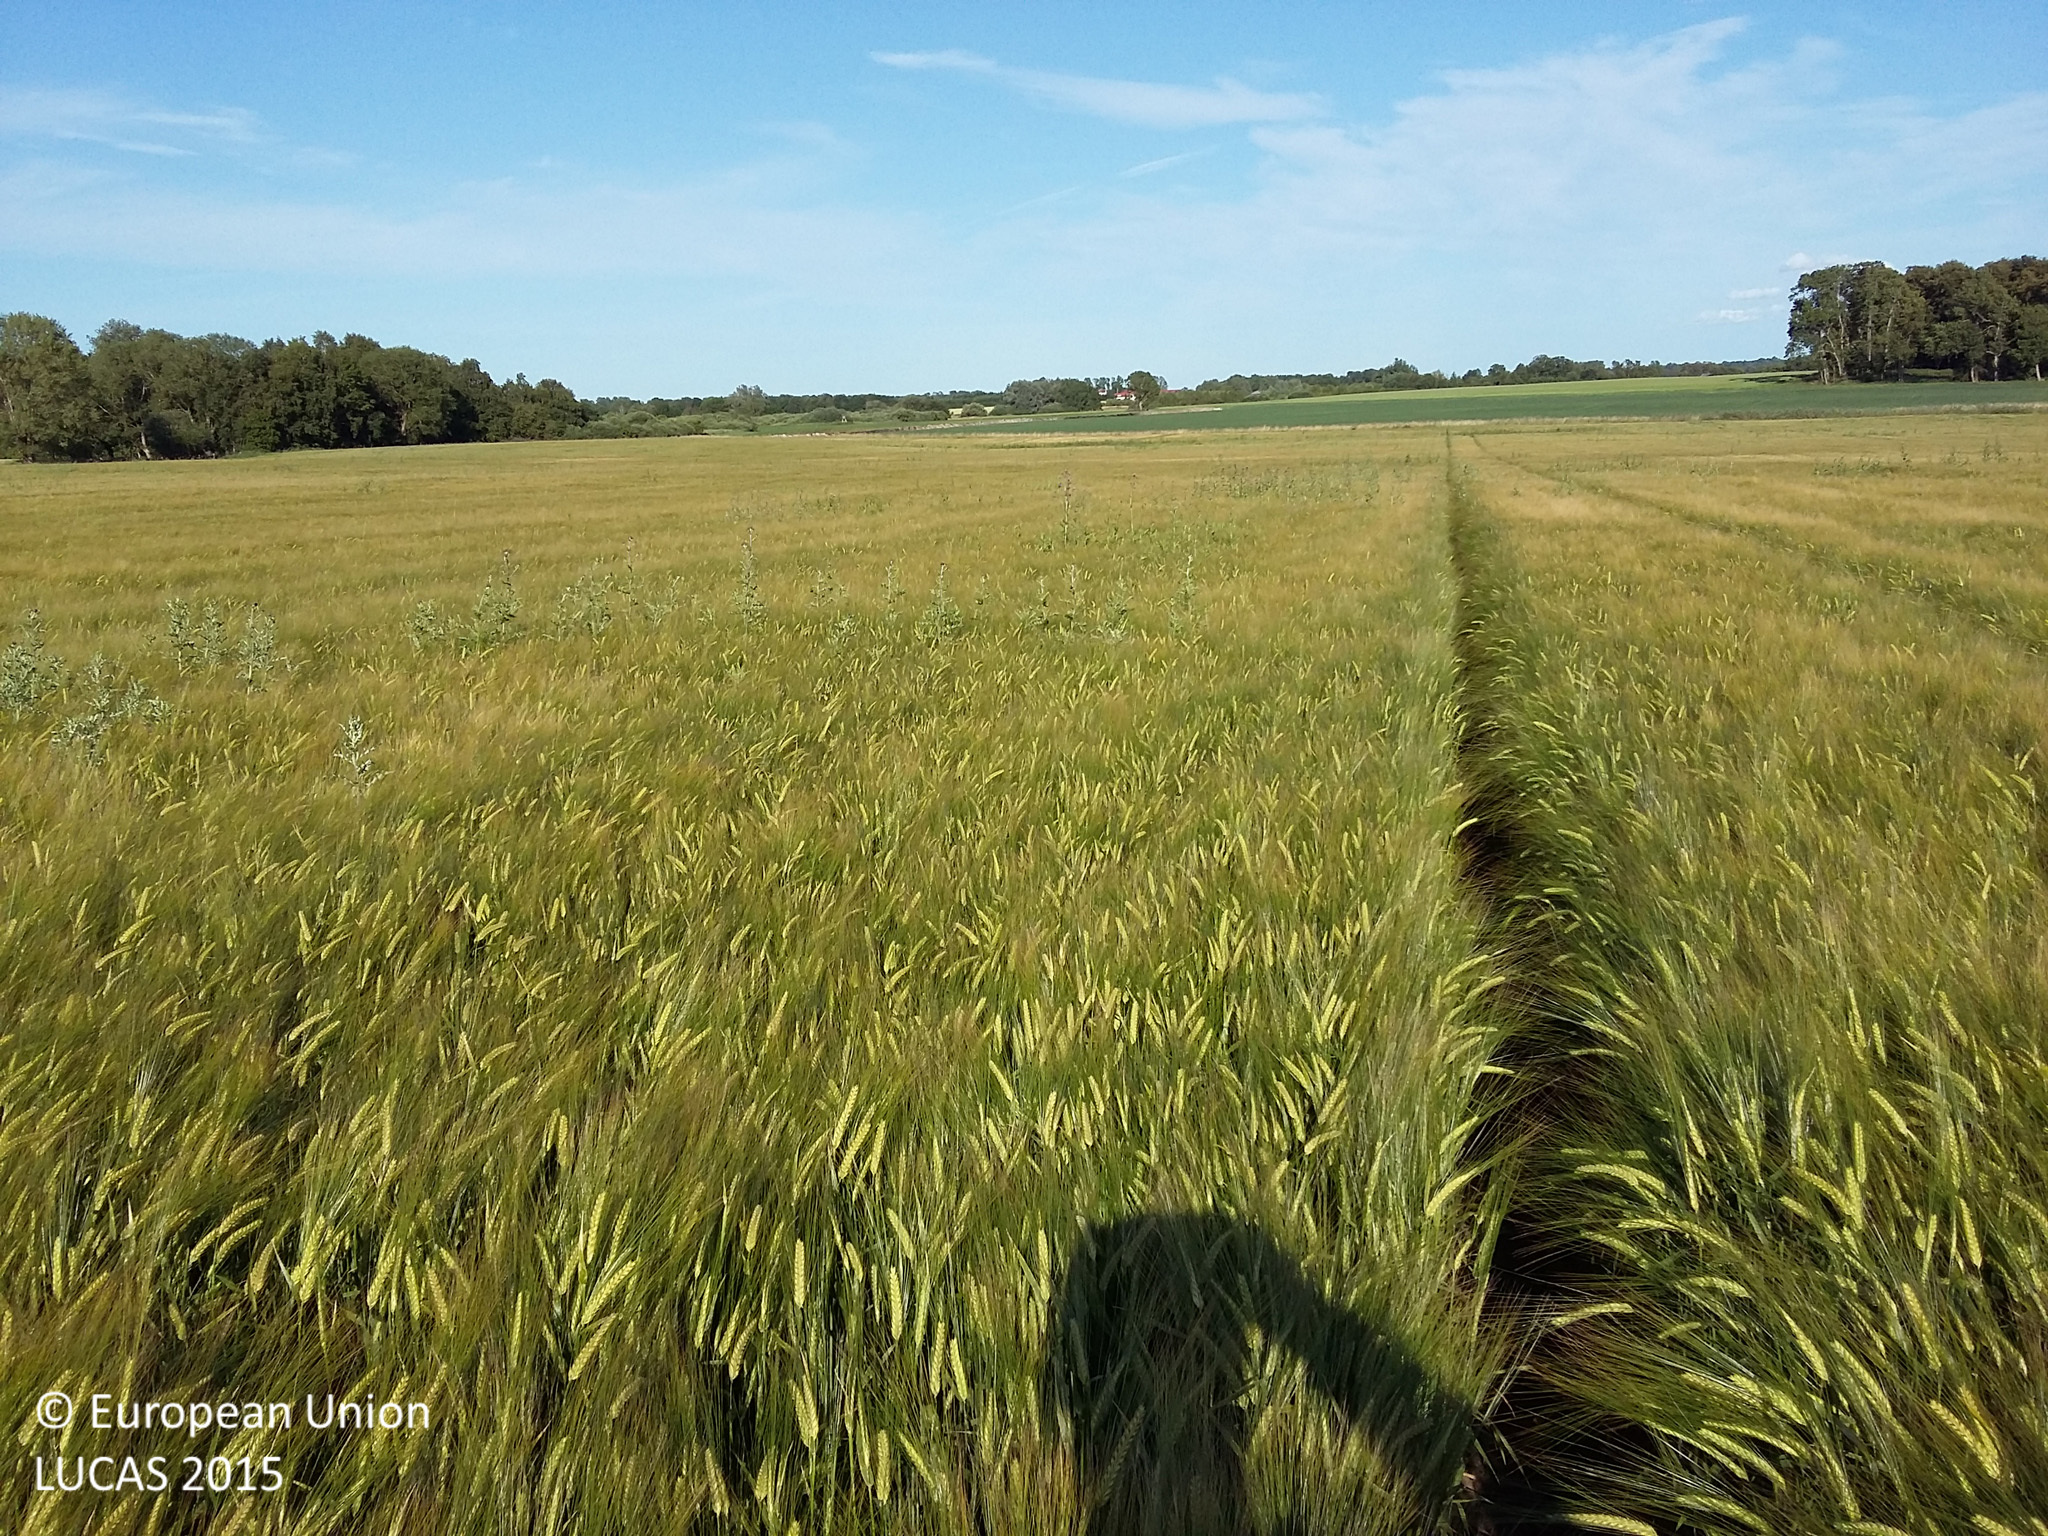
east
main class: Cropland
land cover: Barley
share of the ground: > 75 %
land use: Agriculture (excluding fallow land and kitchen gardens)
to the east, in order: Barley; Grassland without tree/shrub cover
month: July
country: DK
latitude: 55.6755
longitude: 11.5092
